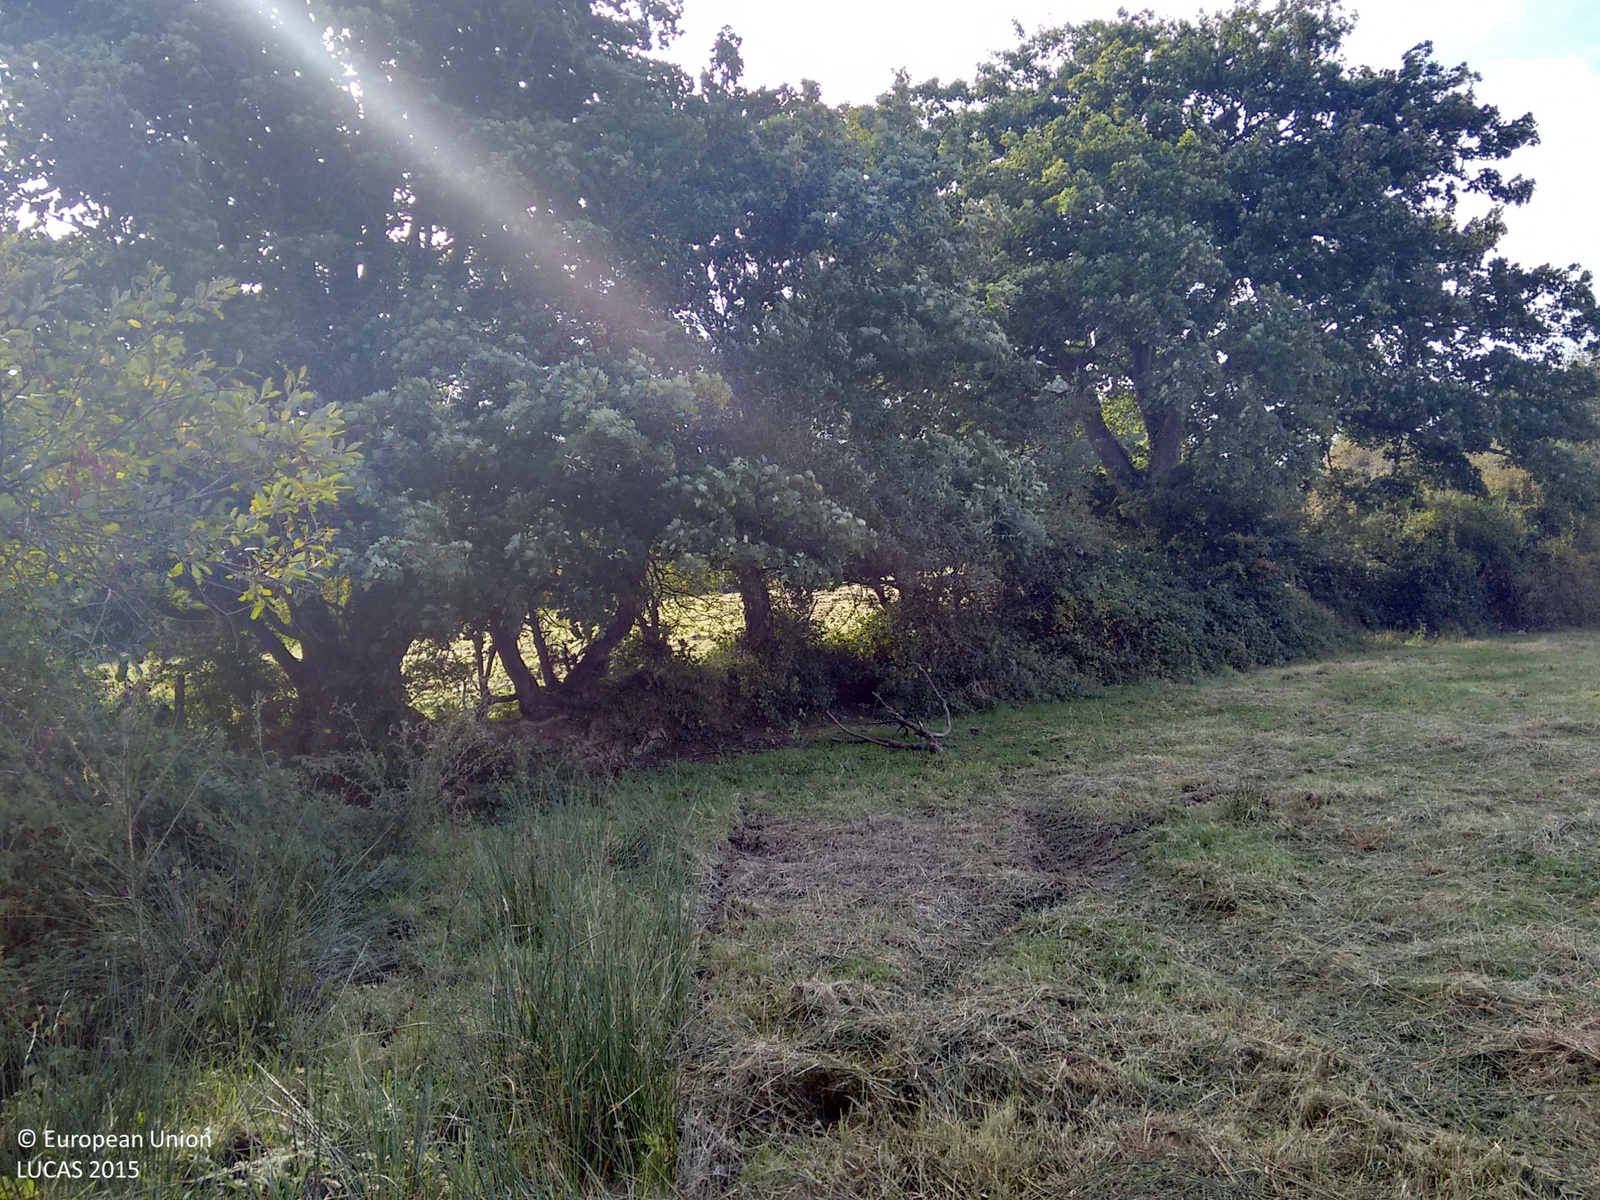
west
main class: Grassland
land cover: Grassland without tree/shrub cover
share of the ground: > 75 %
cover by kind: herbaceous plants 100 %
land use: Agriculture (excluding fallow land and kitchen gardens)
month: September
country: GB
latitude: 52.1391
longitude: -4.4975
